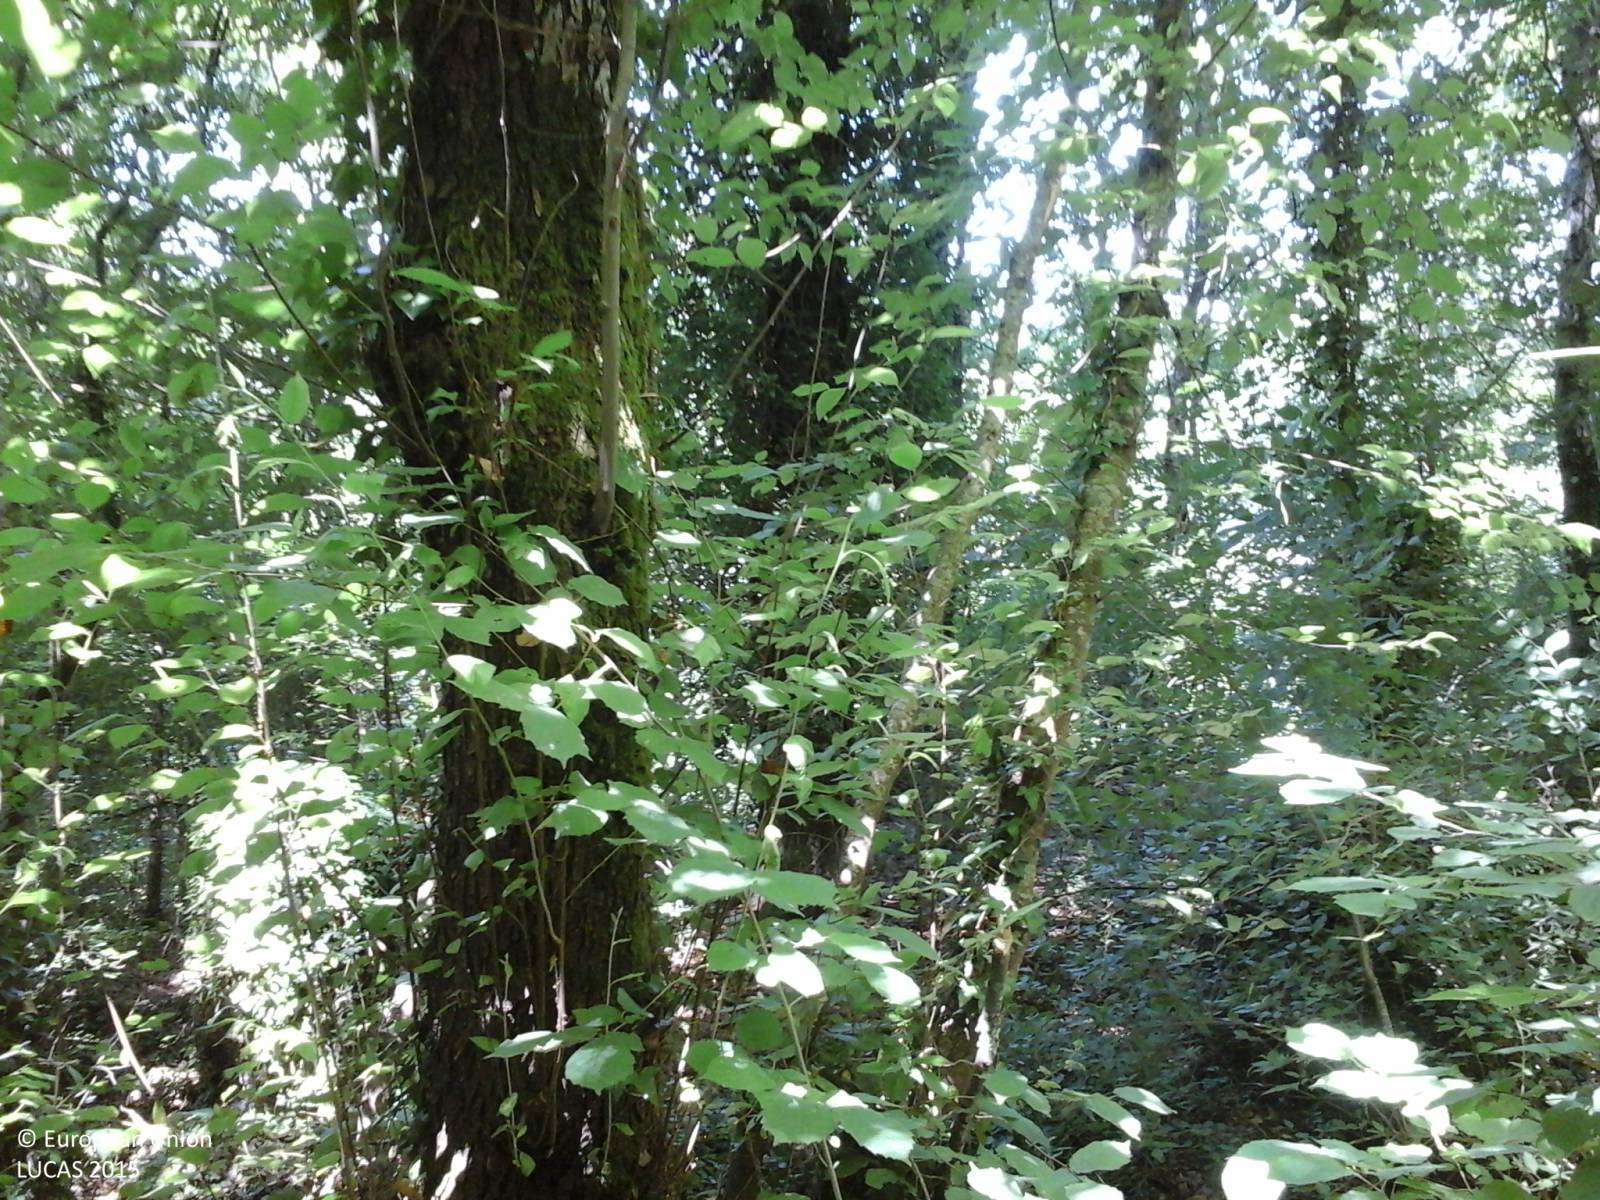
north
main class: Woodland
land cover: Broadleaved woodland
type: thermophilous deciduous forest
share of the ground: > 75 %
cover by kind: broadleaved forest trees 90 %, shrubs 10 %
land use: Forestry
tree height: > 5 m
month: June
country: IT
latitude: 42.5027
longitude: 12.2438
